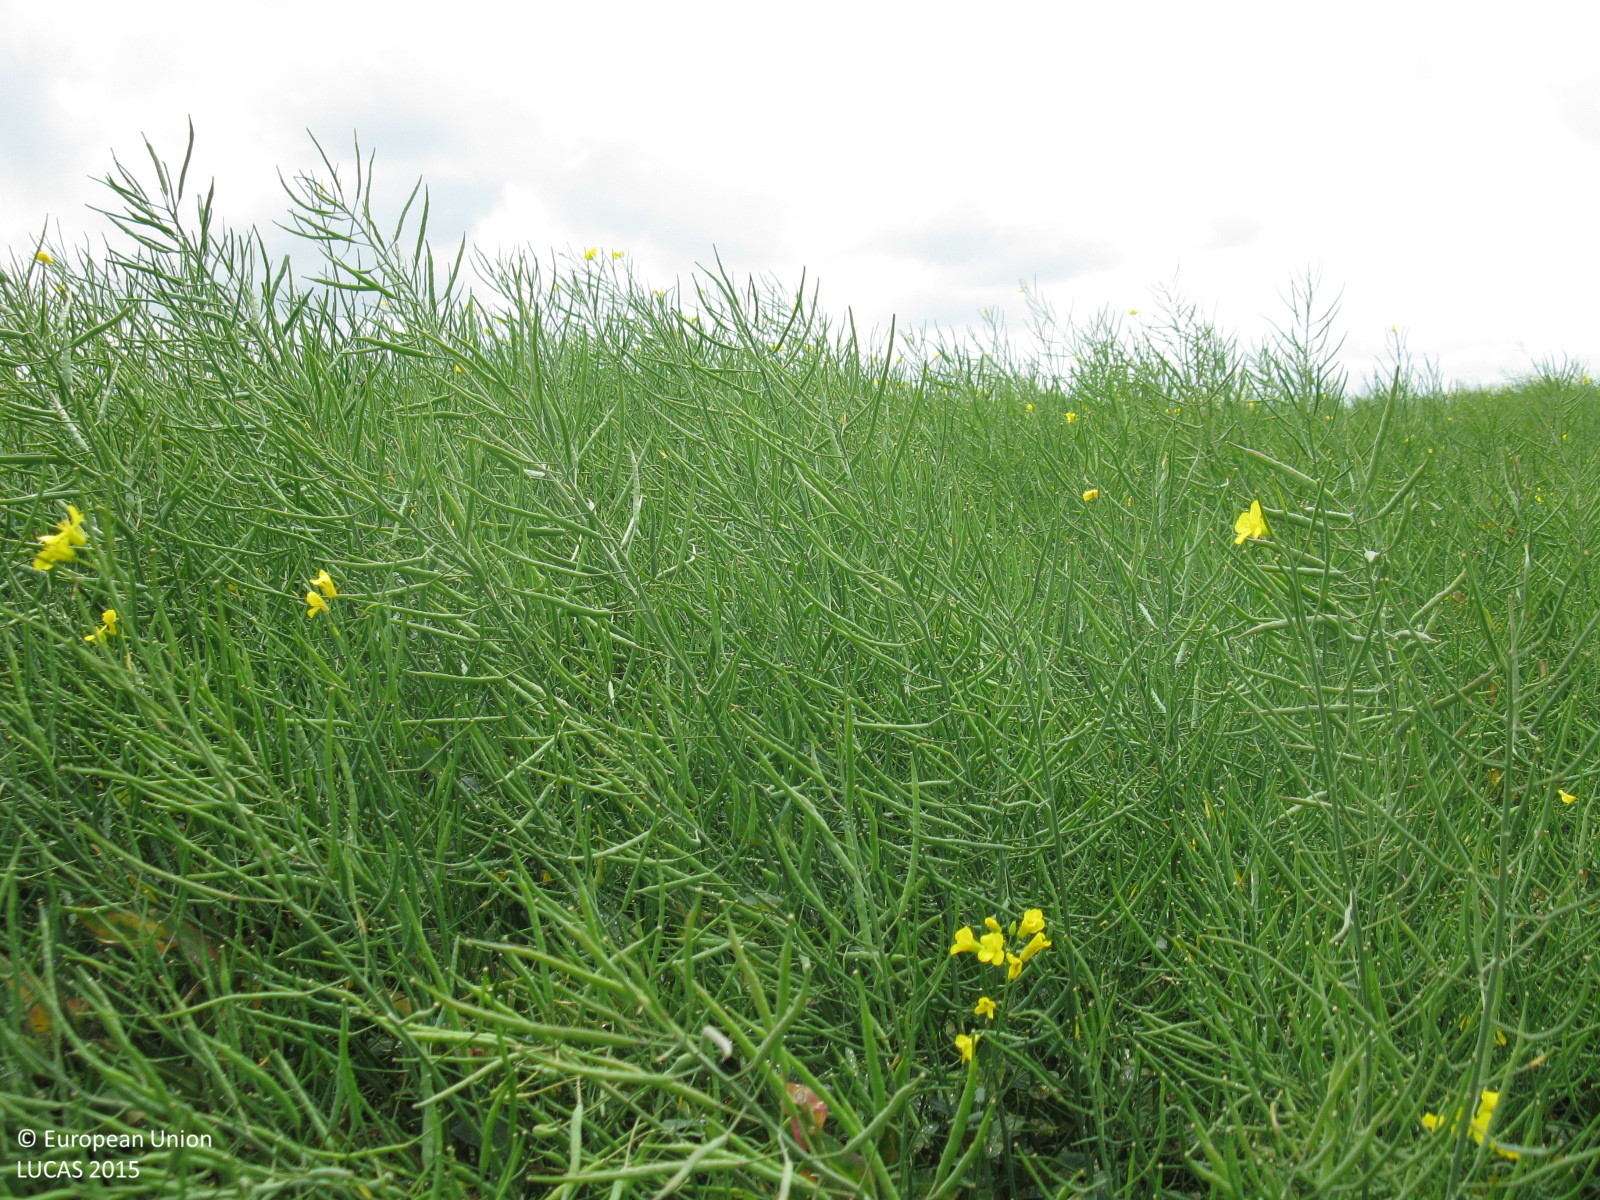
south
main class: Cropland
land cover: Rape and turnip rape
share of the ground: > 75 %
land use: Agriculture (excluding fallow land and kitchen gardens)
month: June
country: DE
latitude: 53.7088
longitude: 7.9858
